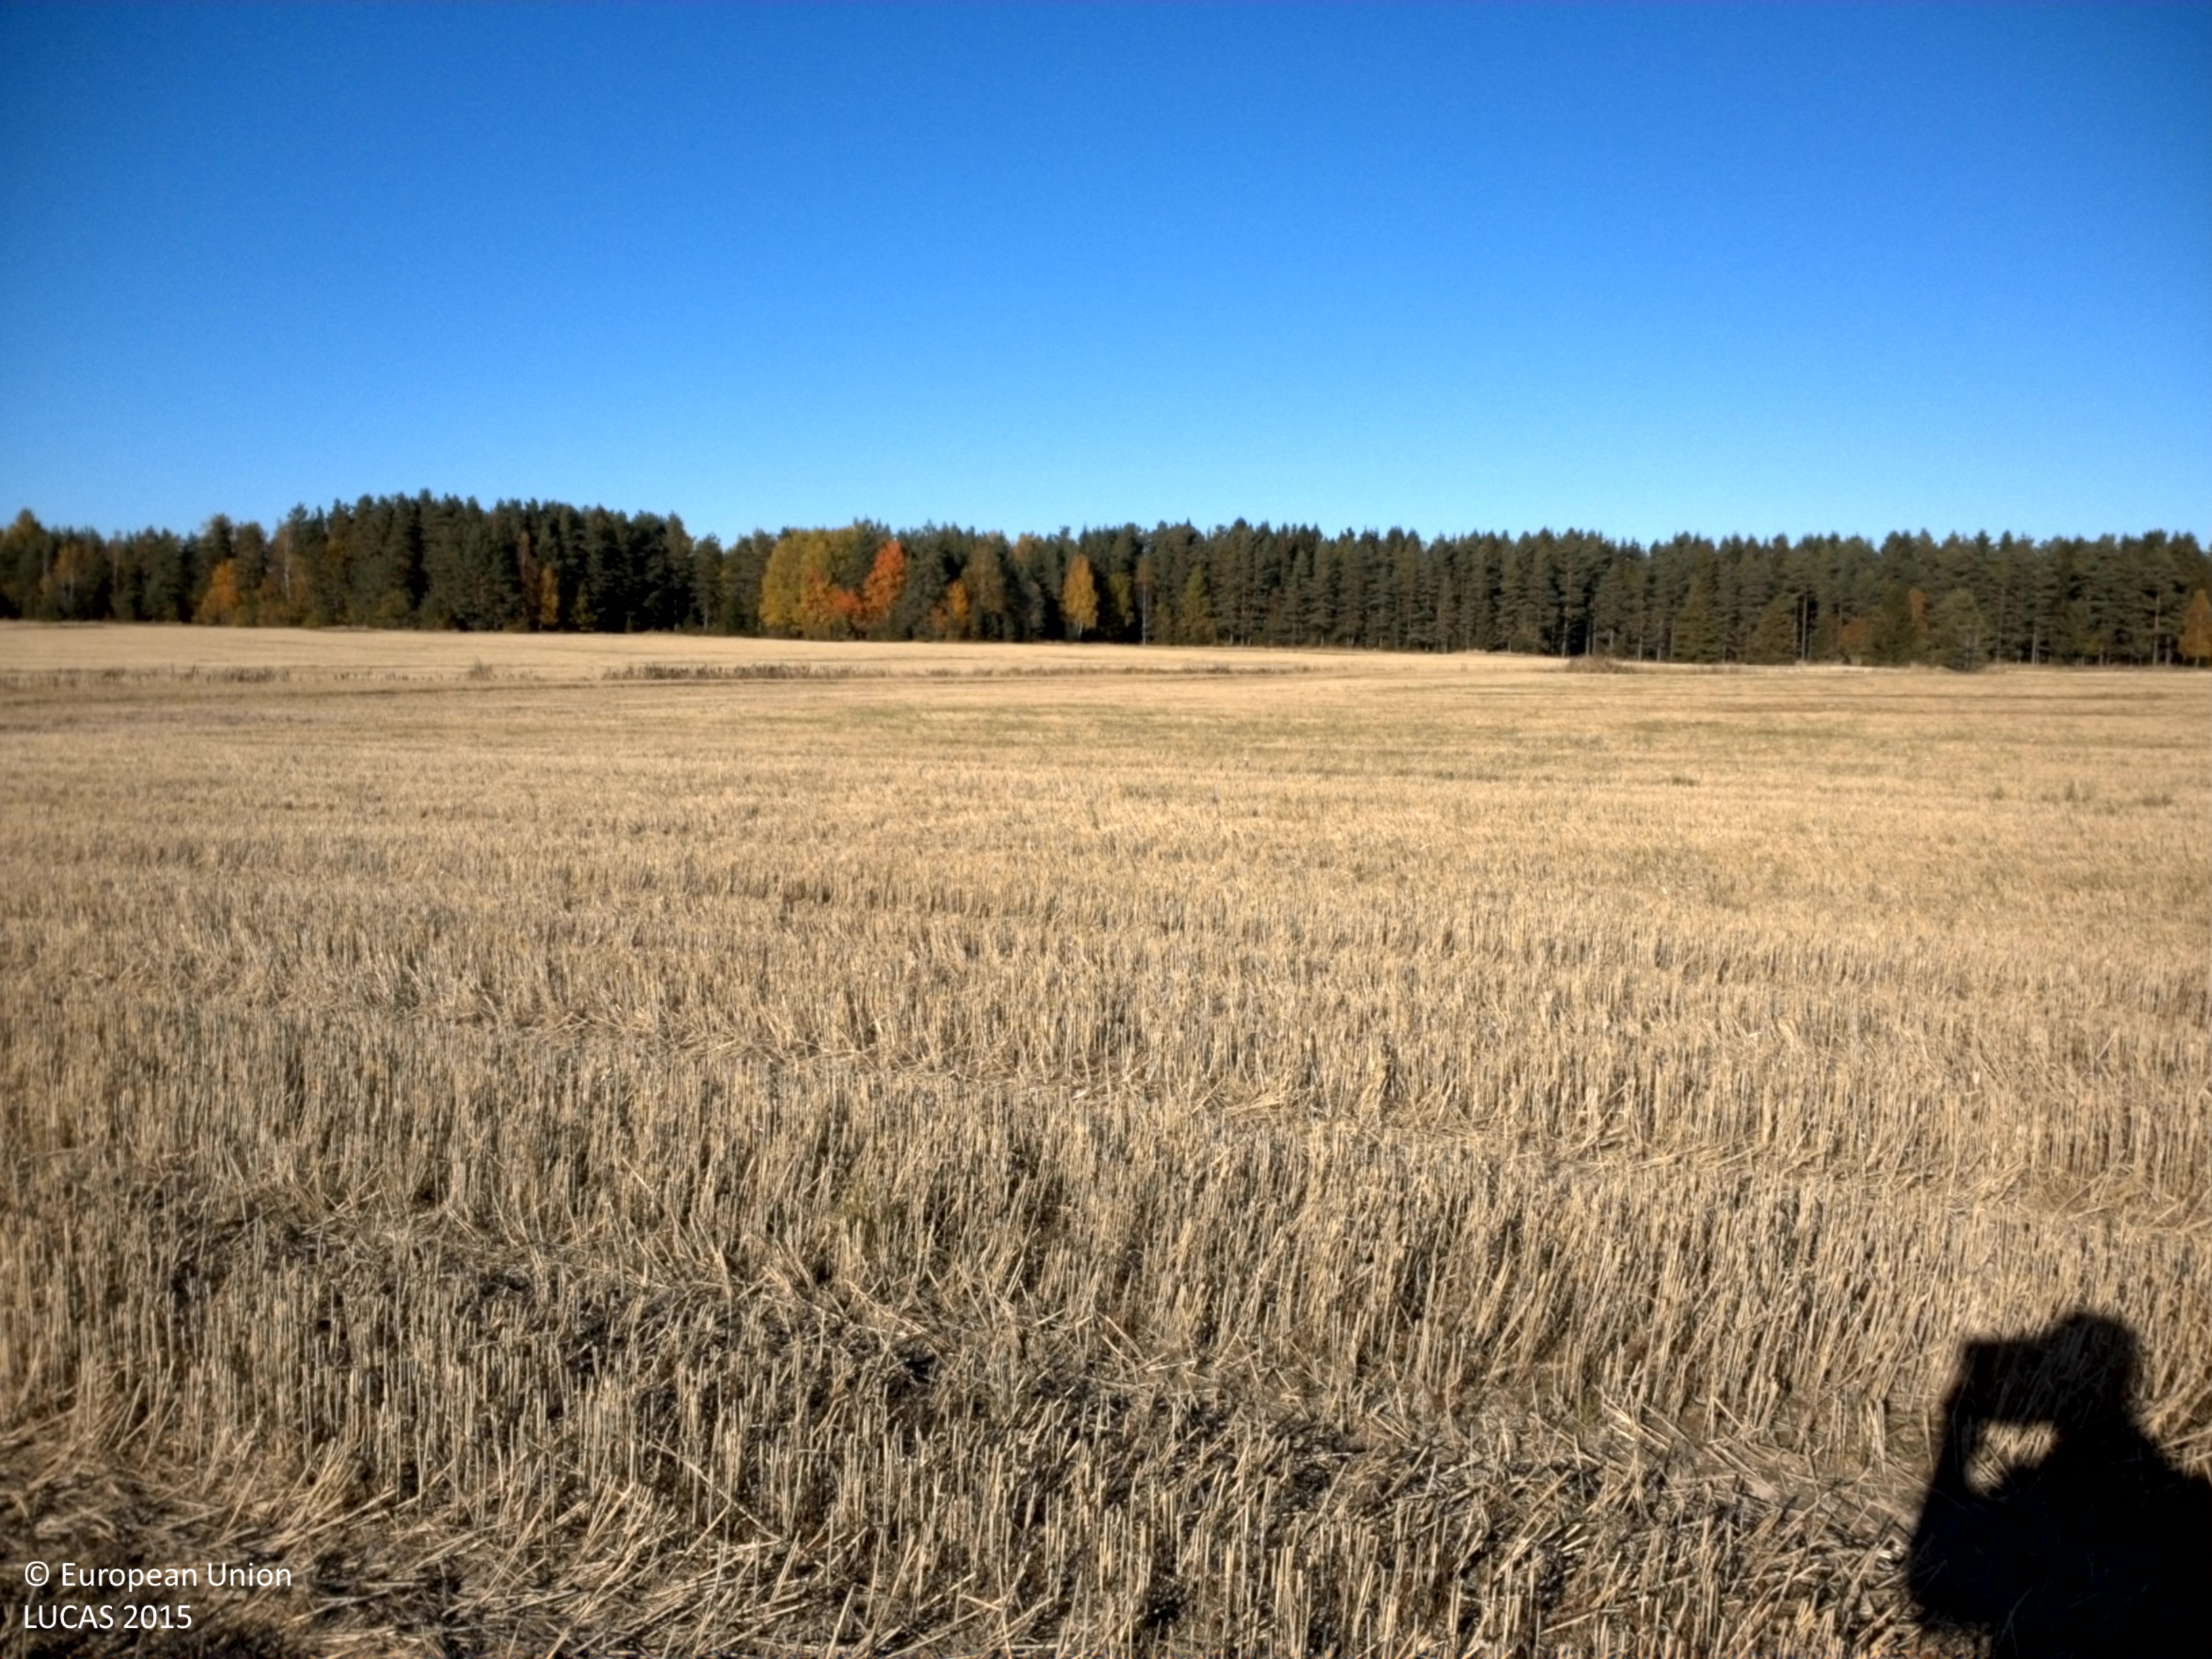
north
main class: Cropland
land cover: Common wheat
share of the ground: > 75 %
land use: Agriculture (excluding fallow land and kitchen gardens)
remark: Harvested field
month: October
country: SE
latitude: 59.0656
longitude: 13.1151
